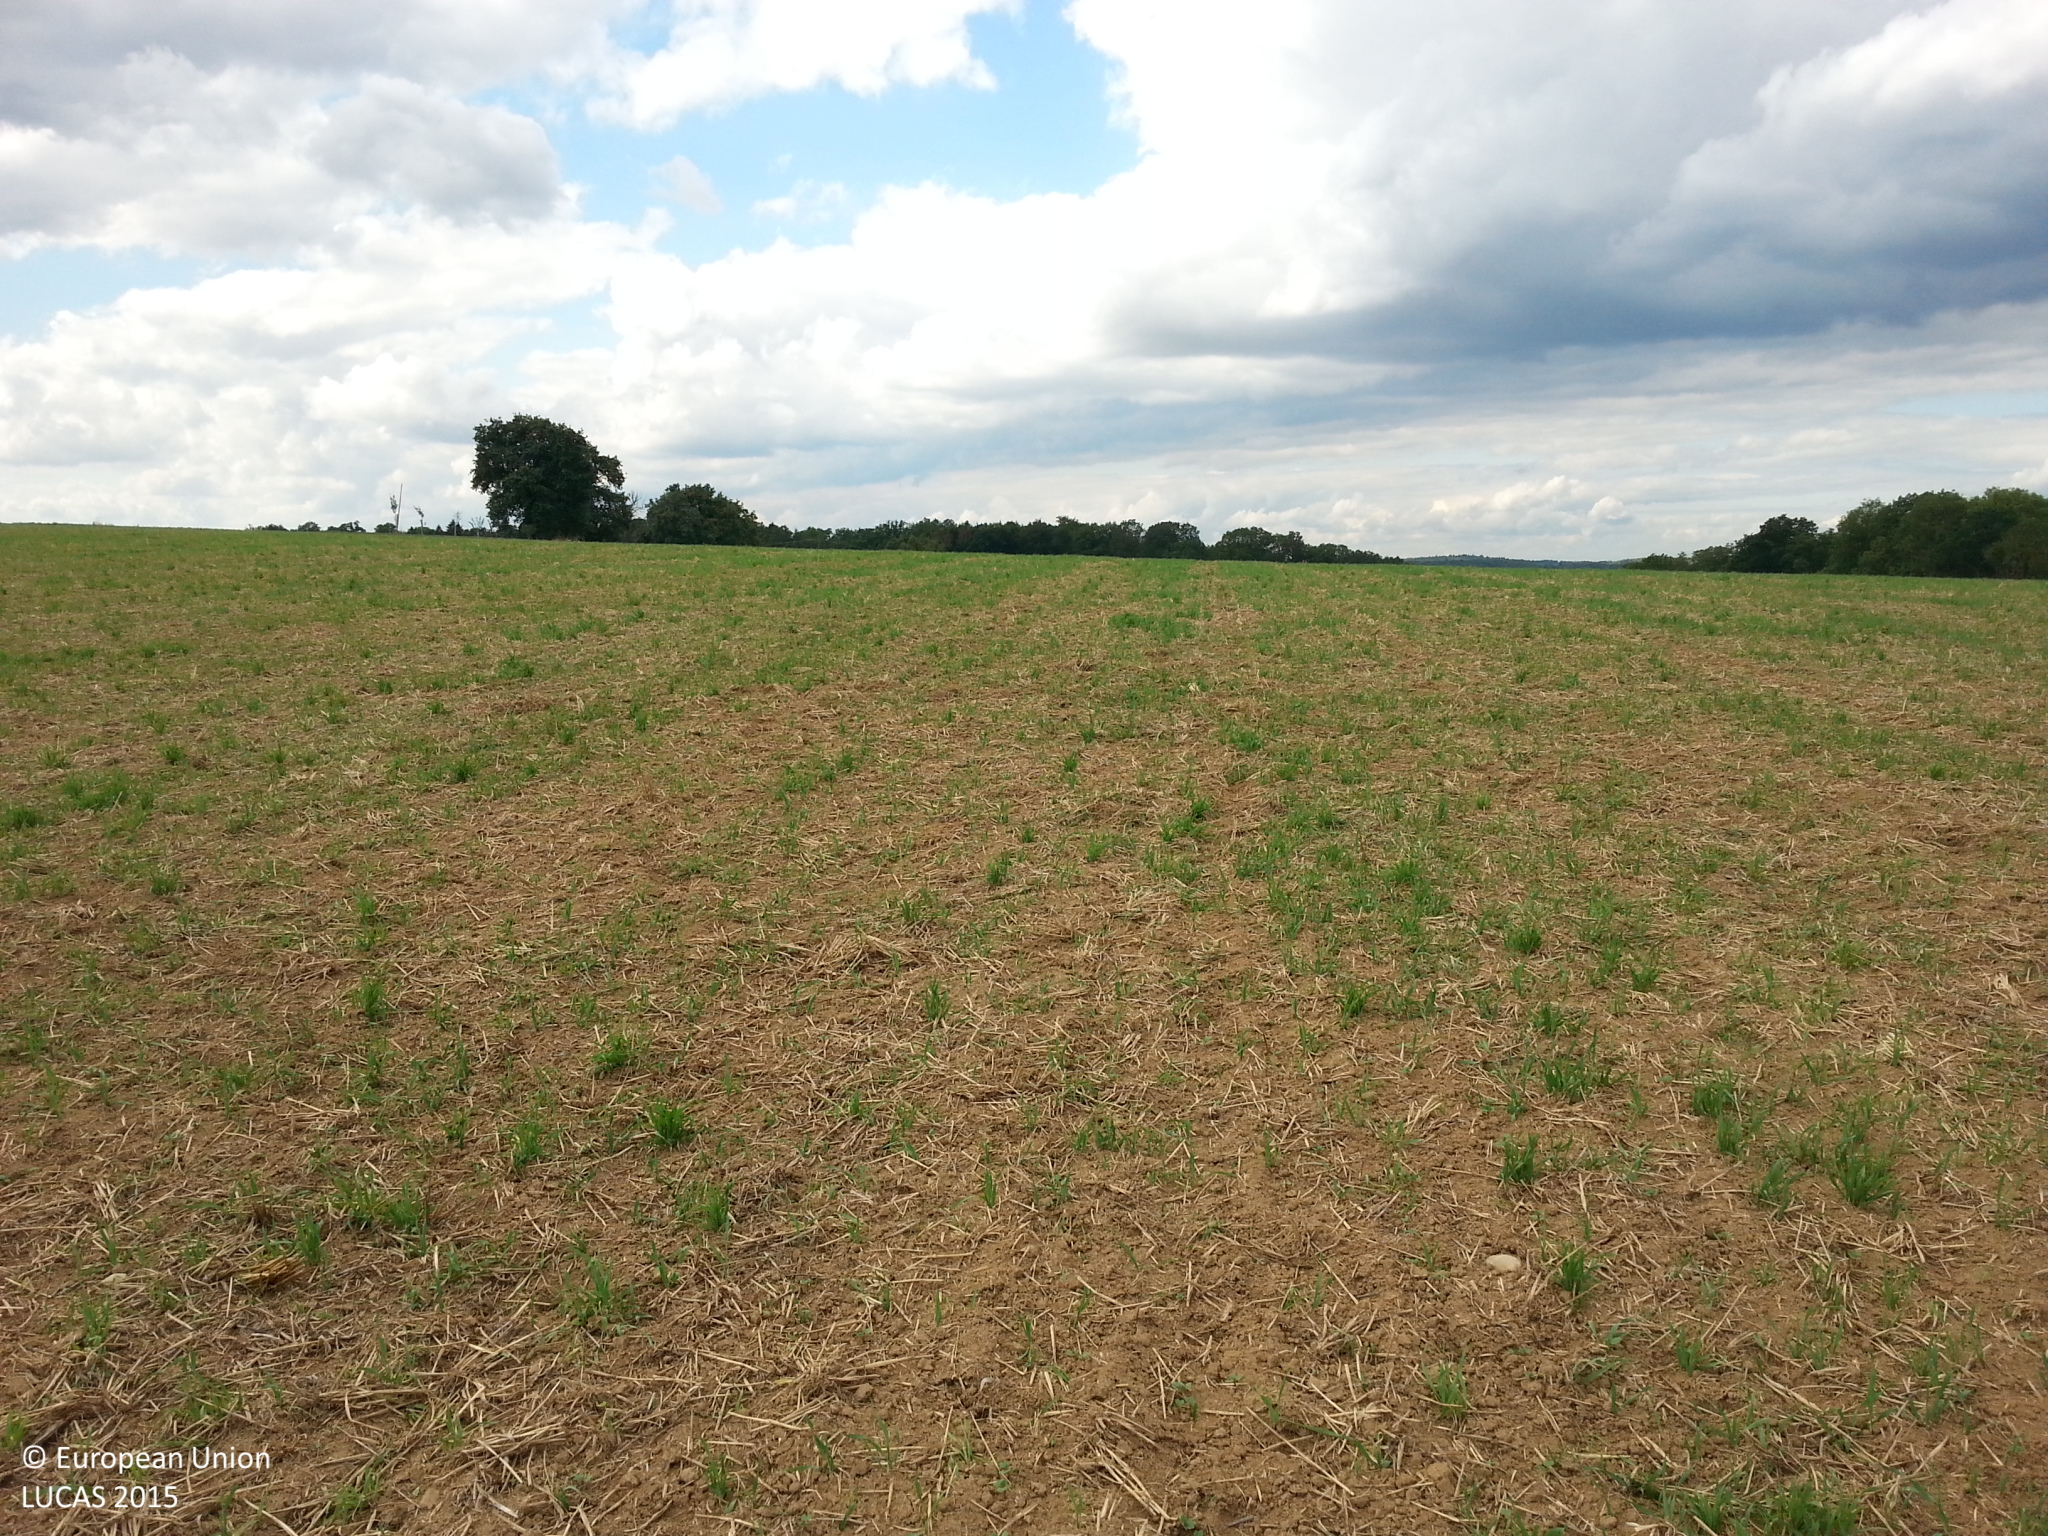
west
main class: Cropland
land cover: Rape and turnip rape
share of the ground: < 10 %
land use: Agriculture (excluding fallow land and kitchen gardens)
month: September
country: DE
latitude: 49.3914
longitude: 9.4078
